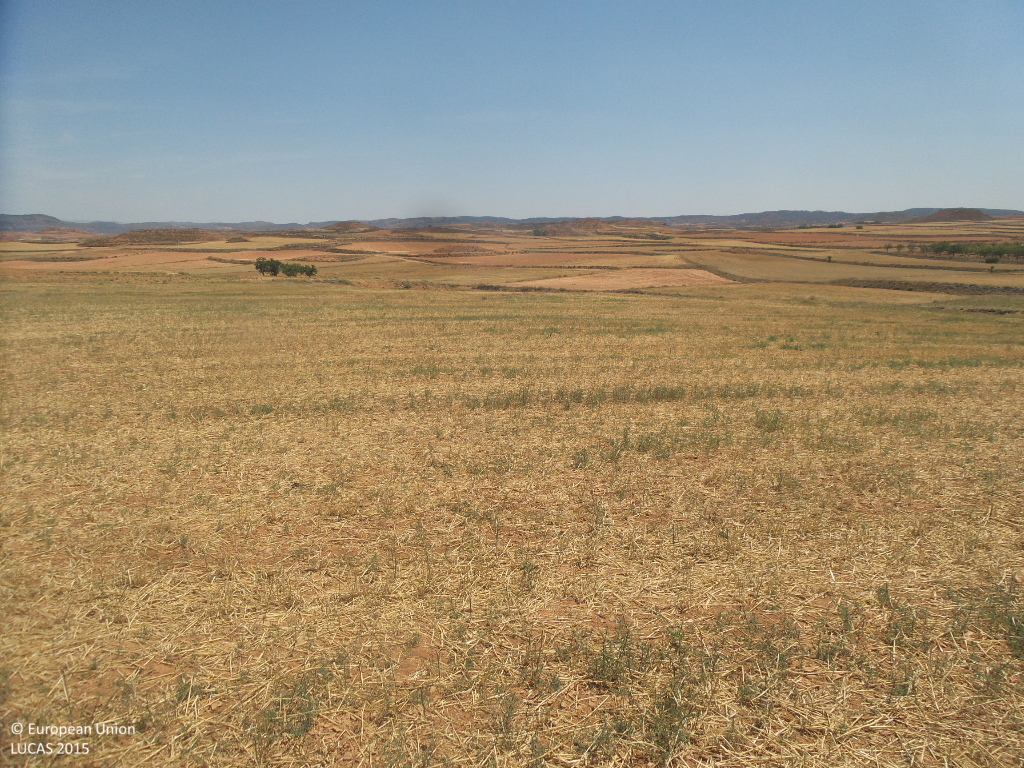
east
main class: Cropland
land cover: Barley
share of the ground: < 10 %
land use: Agriculture (excluding fallow land and kitchen gardens)
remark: Harvested field
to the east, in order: Barley; Grass margins; Spontaneously vegetated surfaces; Shrubland without tree cover; Tracks; Grassland without tree/shrub cover; Shrubland without tree cover; Single bushes/trees
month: July
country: ES
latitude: 41.2835
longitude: -1.9795
